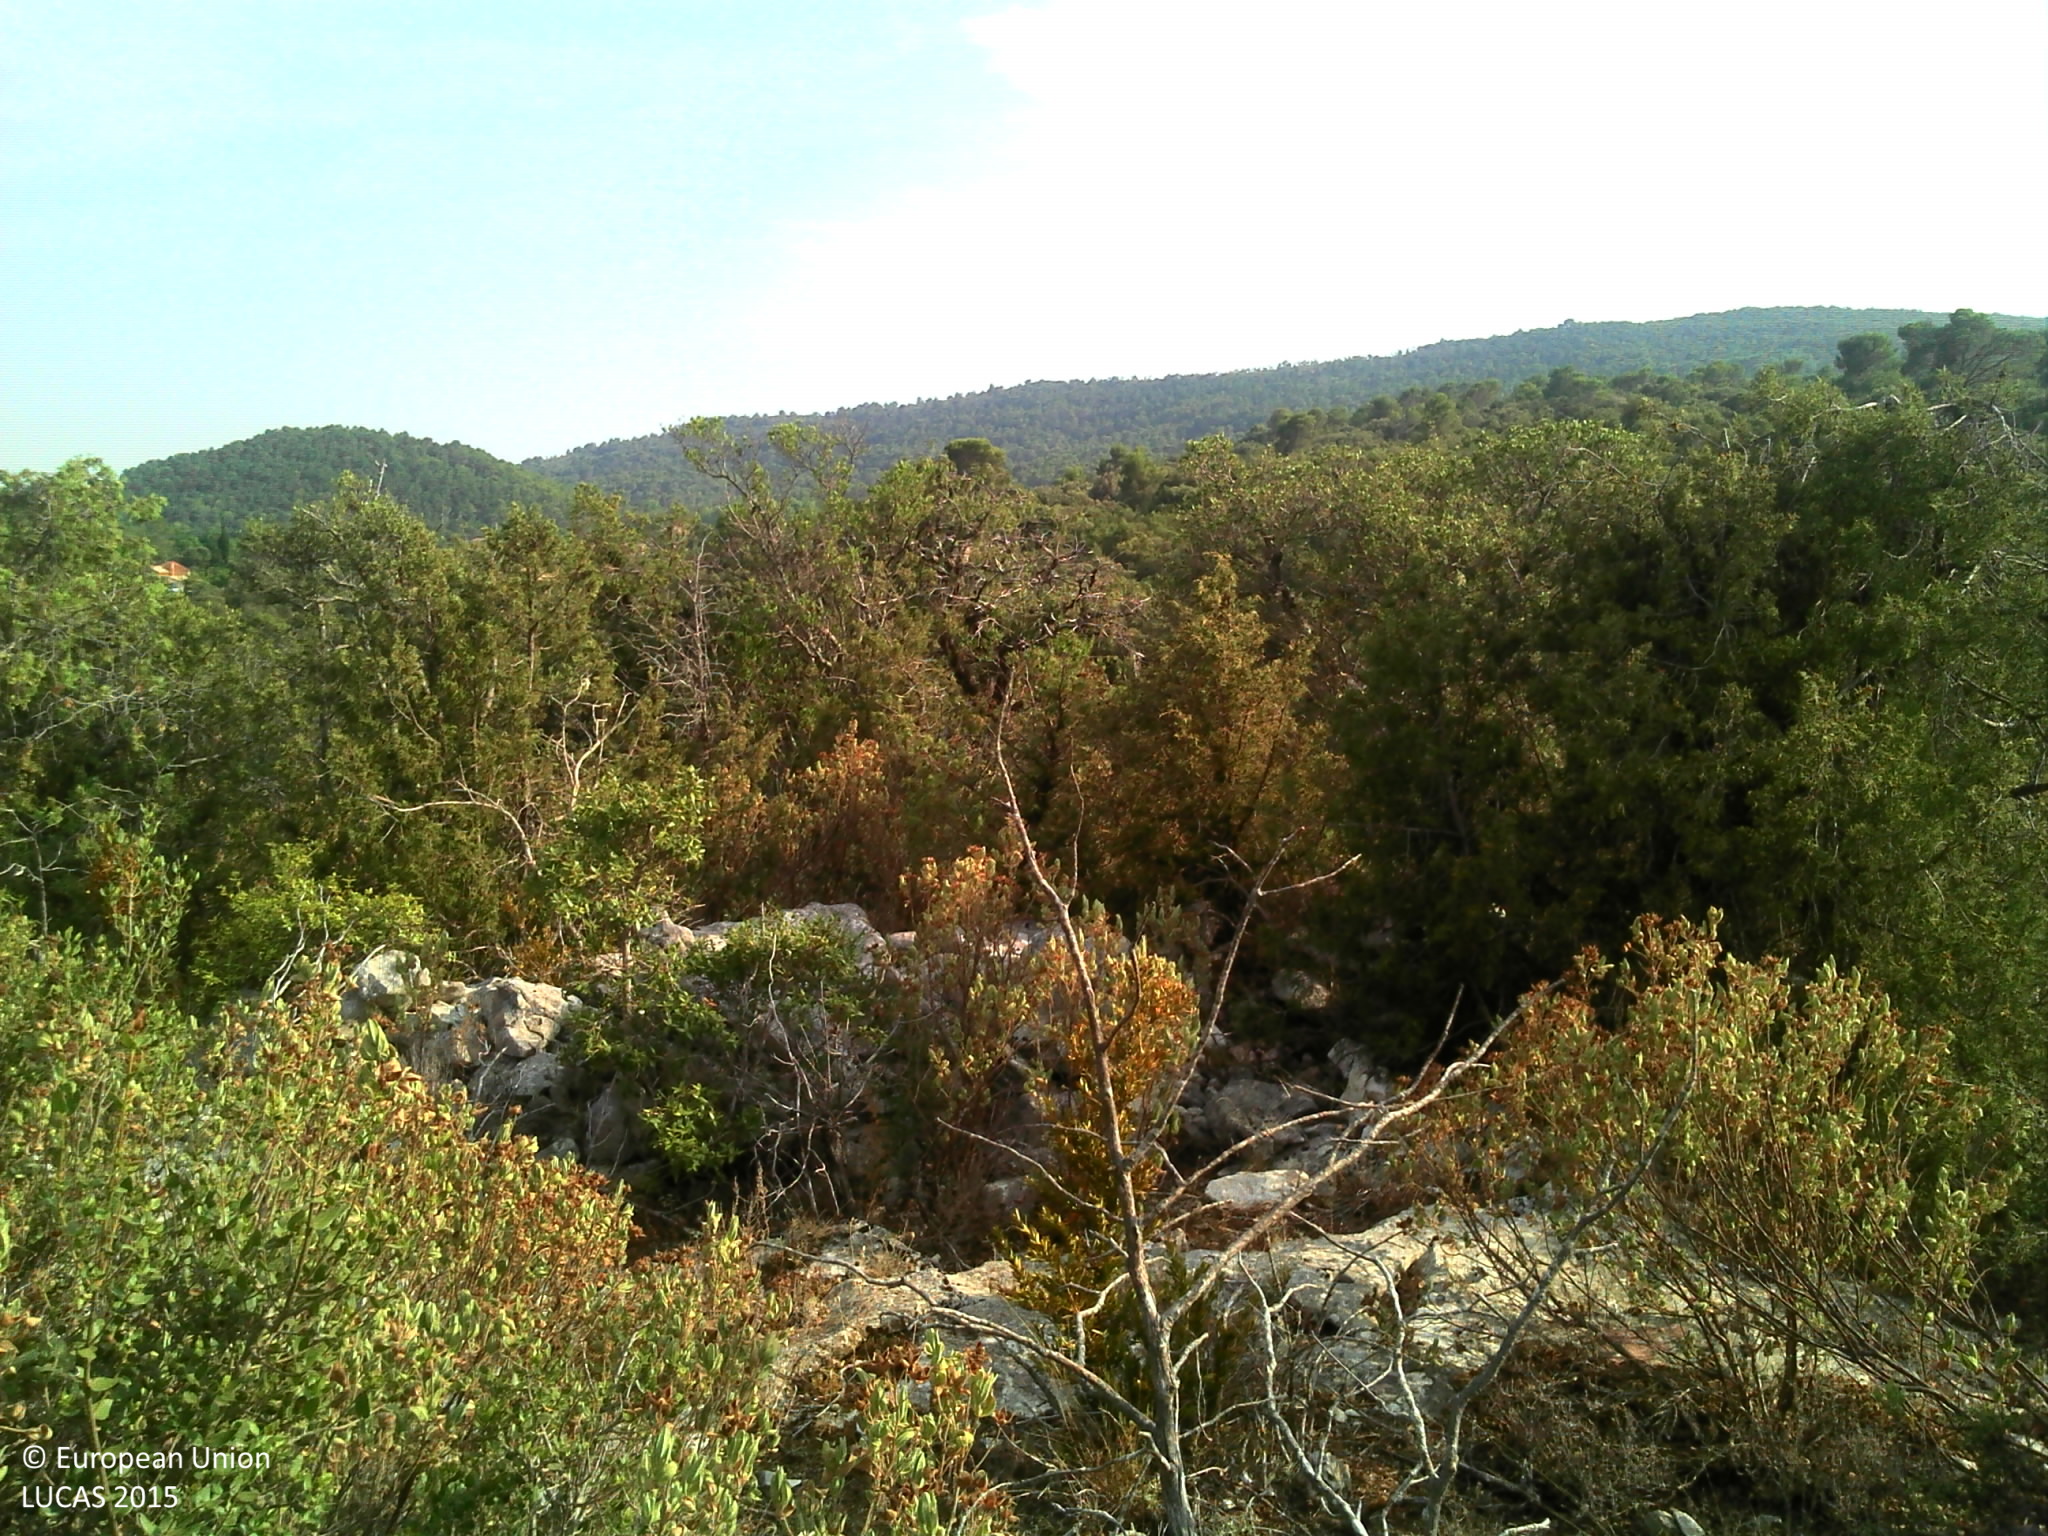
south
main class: Shrubland
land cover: Shrubland without tree cover
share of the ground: > 75 %
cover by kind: shrubs 70 %, unconsolidated bare surface 30 %
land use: Semi-natural and natural areas not in use
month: August
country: FR
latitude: 43.6012
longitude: 6.3787
